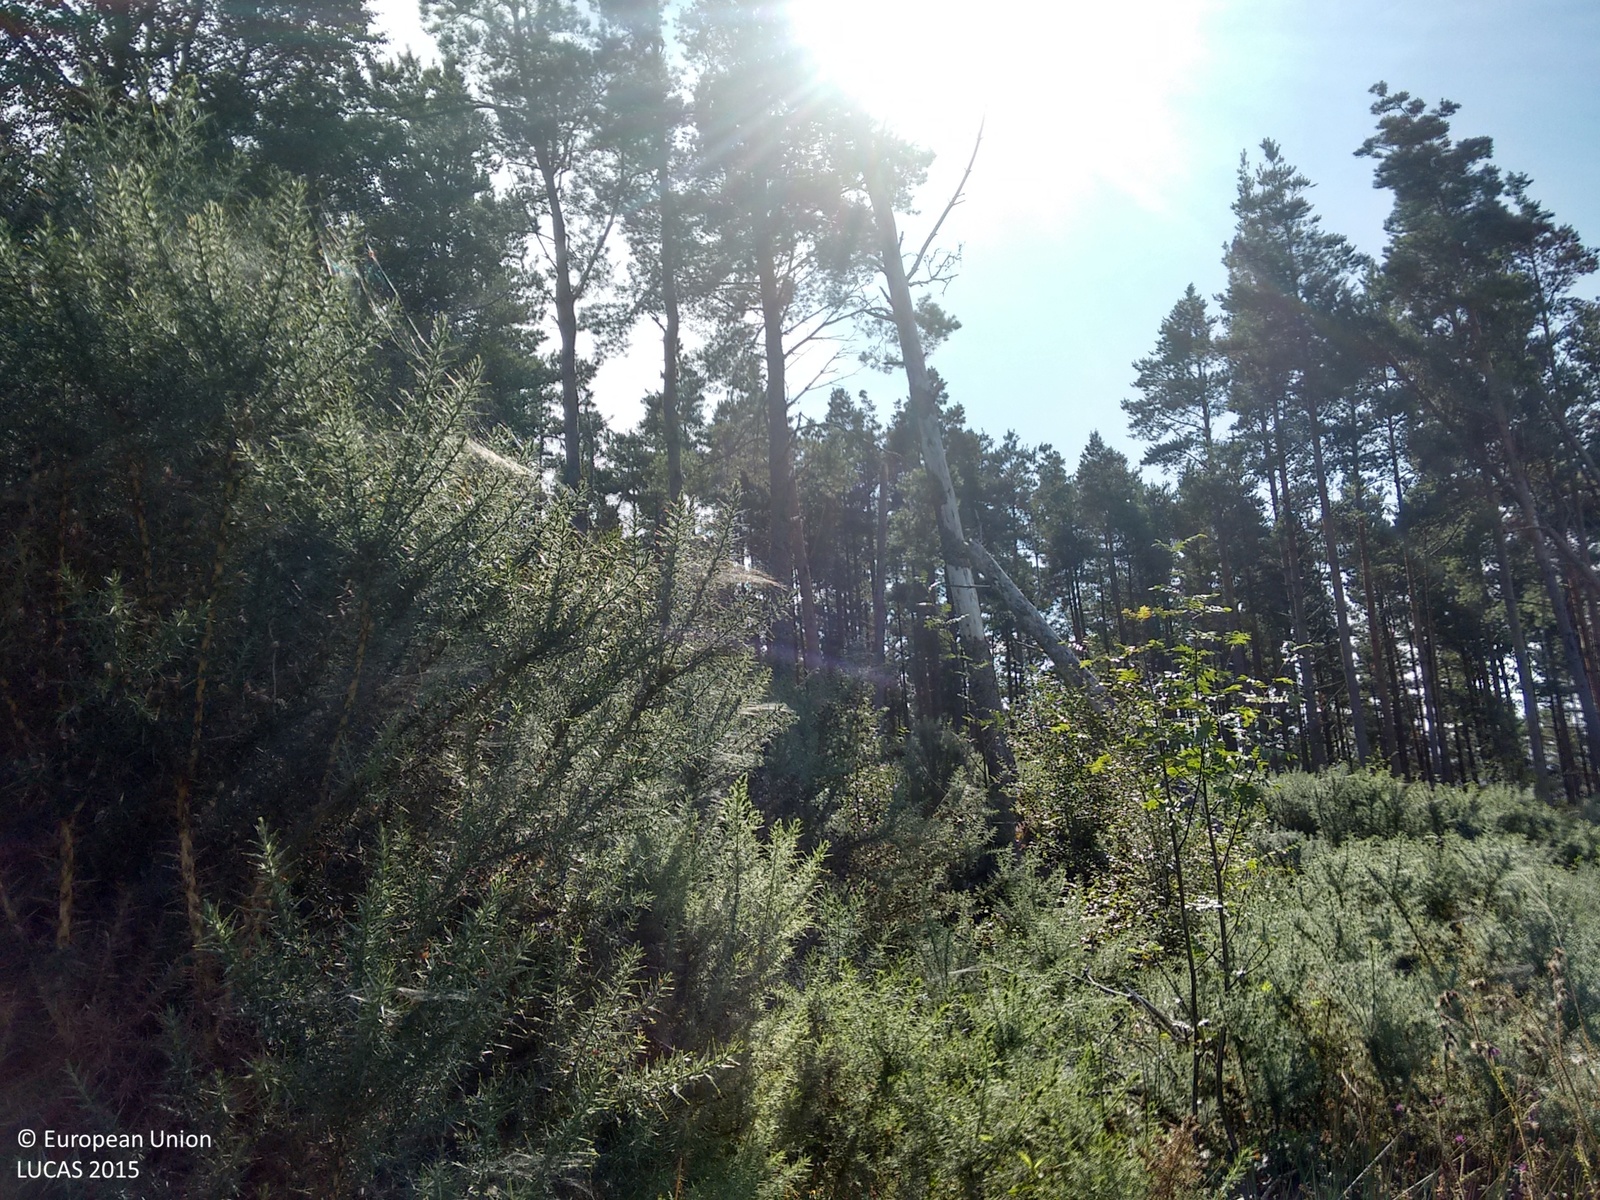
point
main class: Woodland
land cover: Pine dominated coniferous woodland
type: exotic forest
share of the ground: > 75 %
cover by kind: coniferous forest trees 80 %, shrubs 10 %, herbaceous plants 10 %
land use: Forestry
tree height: > 5 m
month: September
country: GB
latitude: 57.8848
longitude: -4.3363
